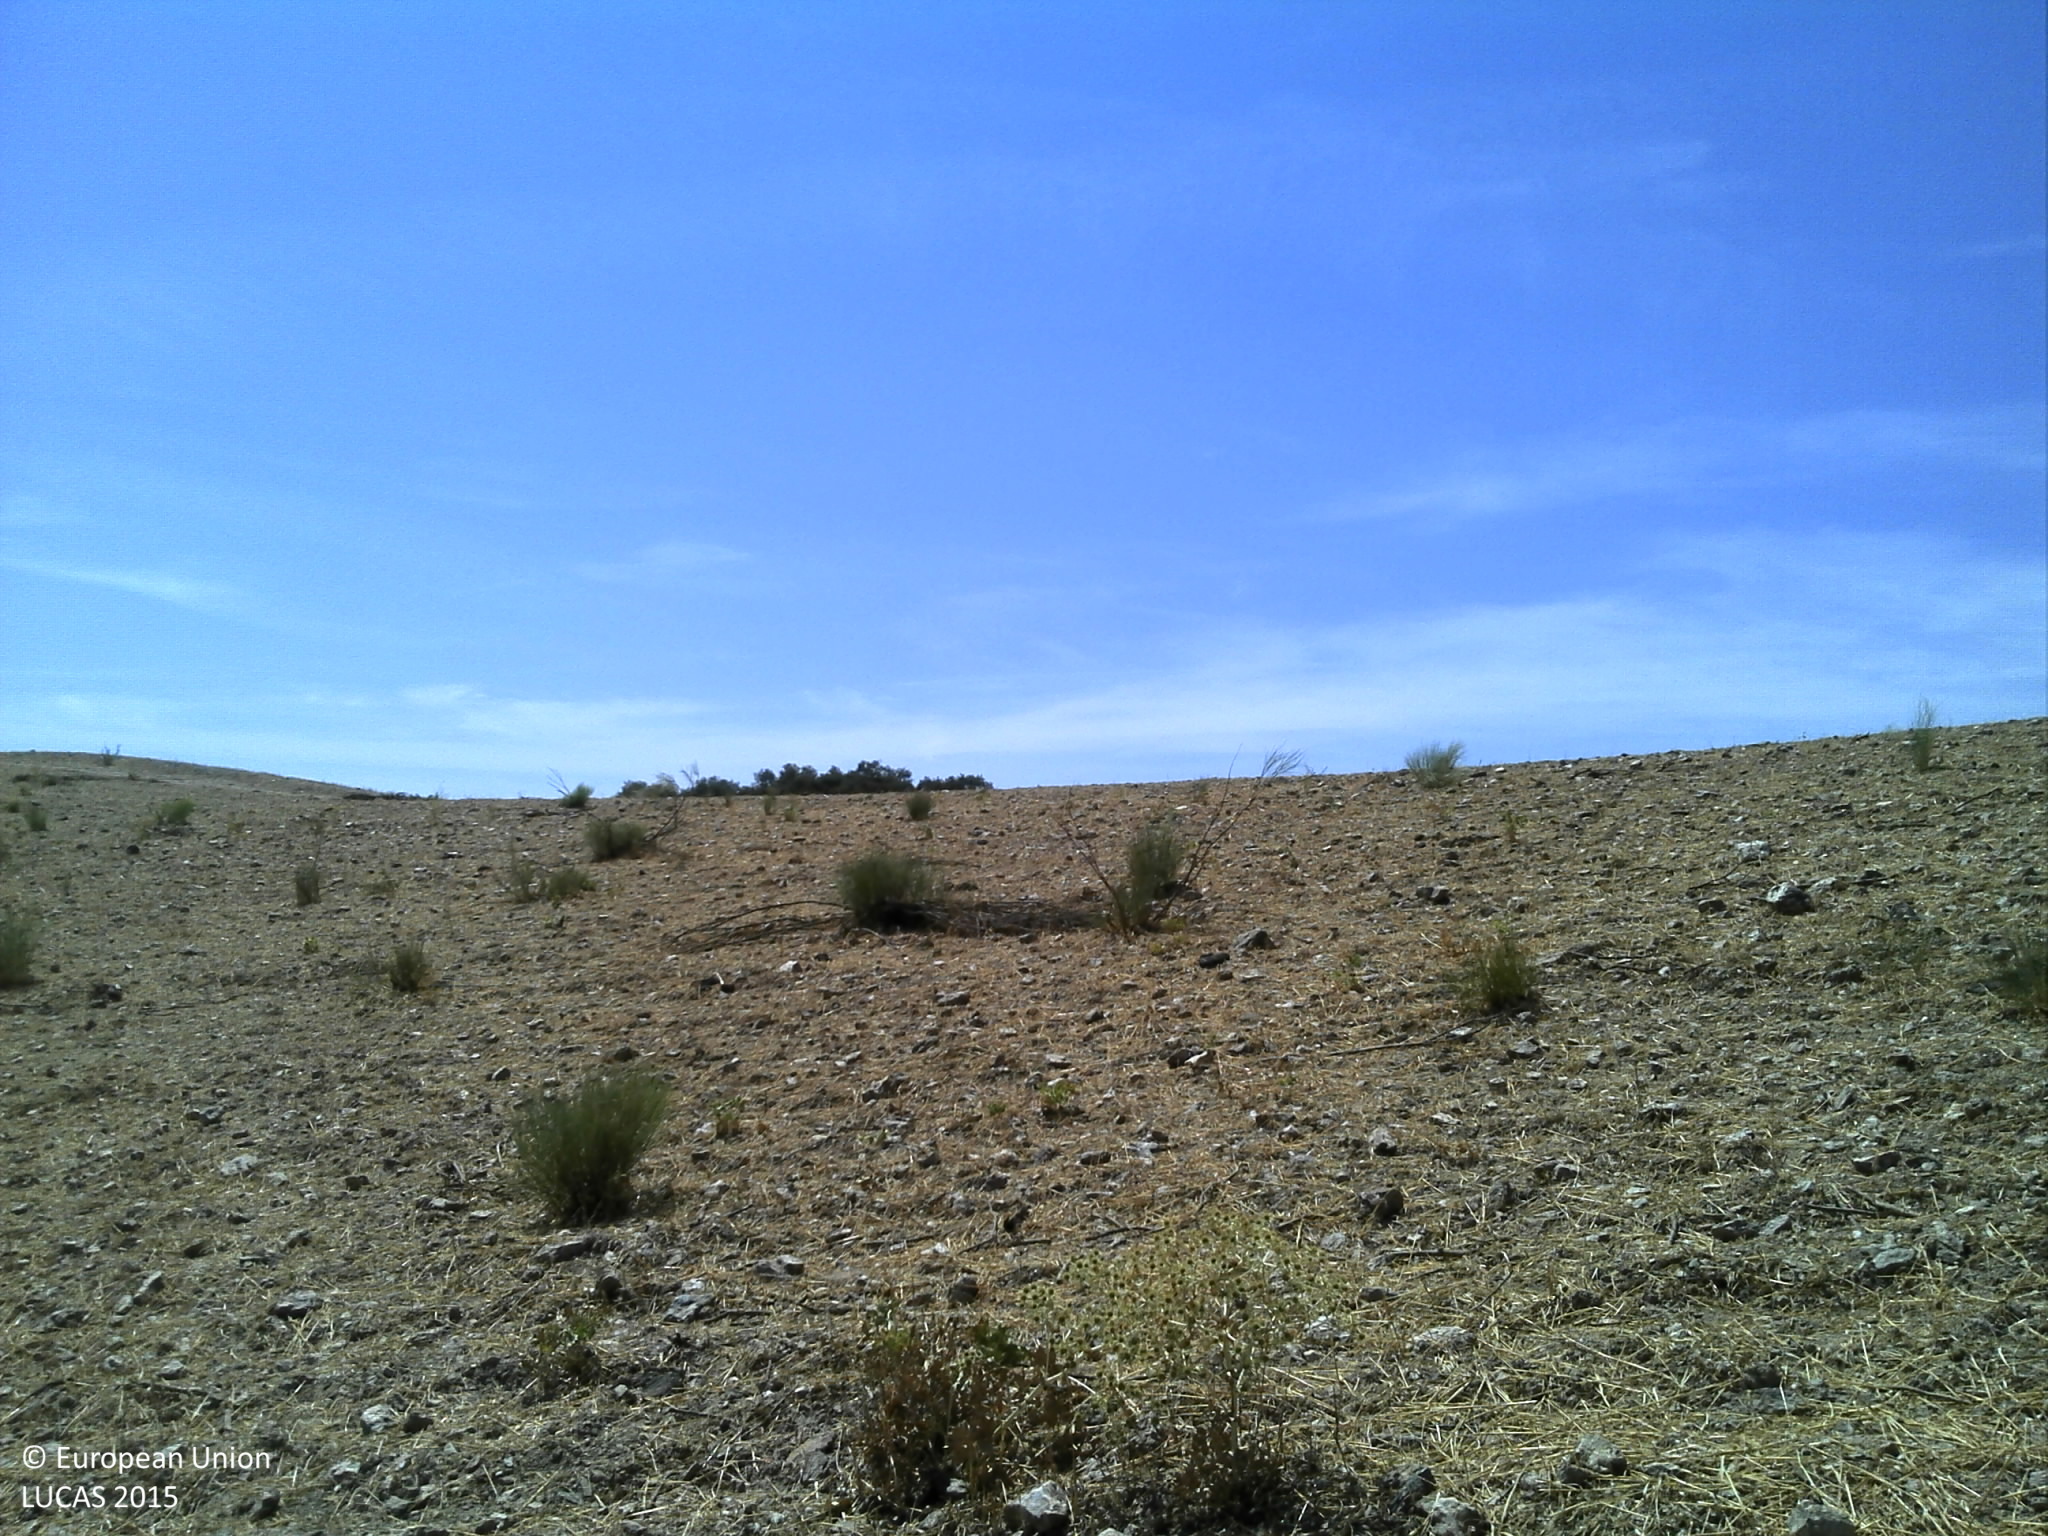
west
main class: Cropland
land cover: Oats
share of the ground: < 10 %
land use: Agriculture (excluding fallow land and kitchen gardens)
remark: Harvested field
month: July
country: PT
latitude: 38.4157
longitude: -7.6333
